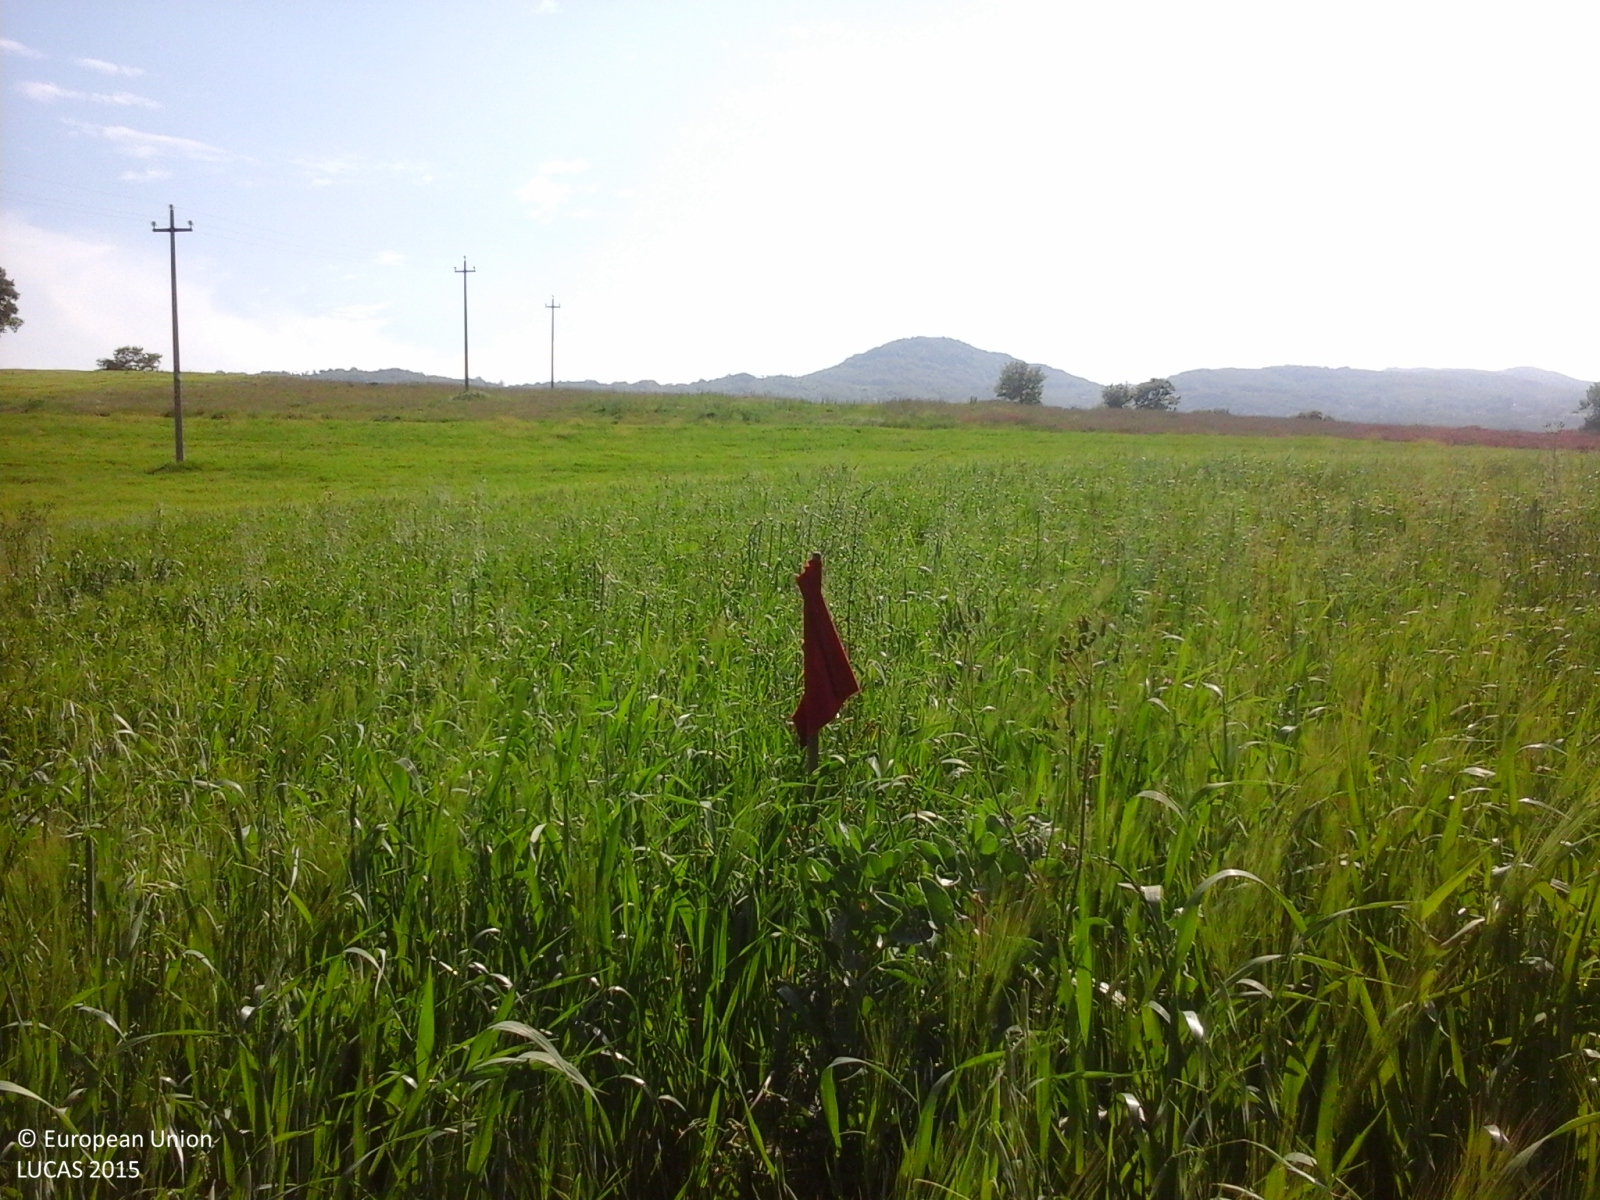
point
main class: Cropland
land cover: Barley
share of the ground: > 75 %
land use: Agriculture (excluding fallow land and kitchen gardens)
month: May
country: IT
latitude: 41.3323
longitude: 14.7026
